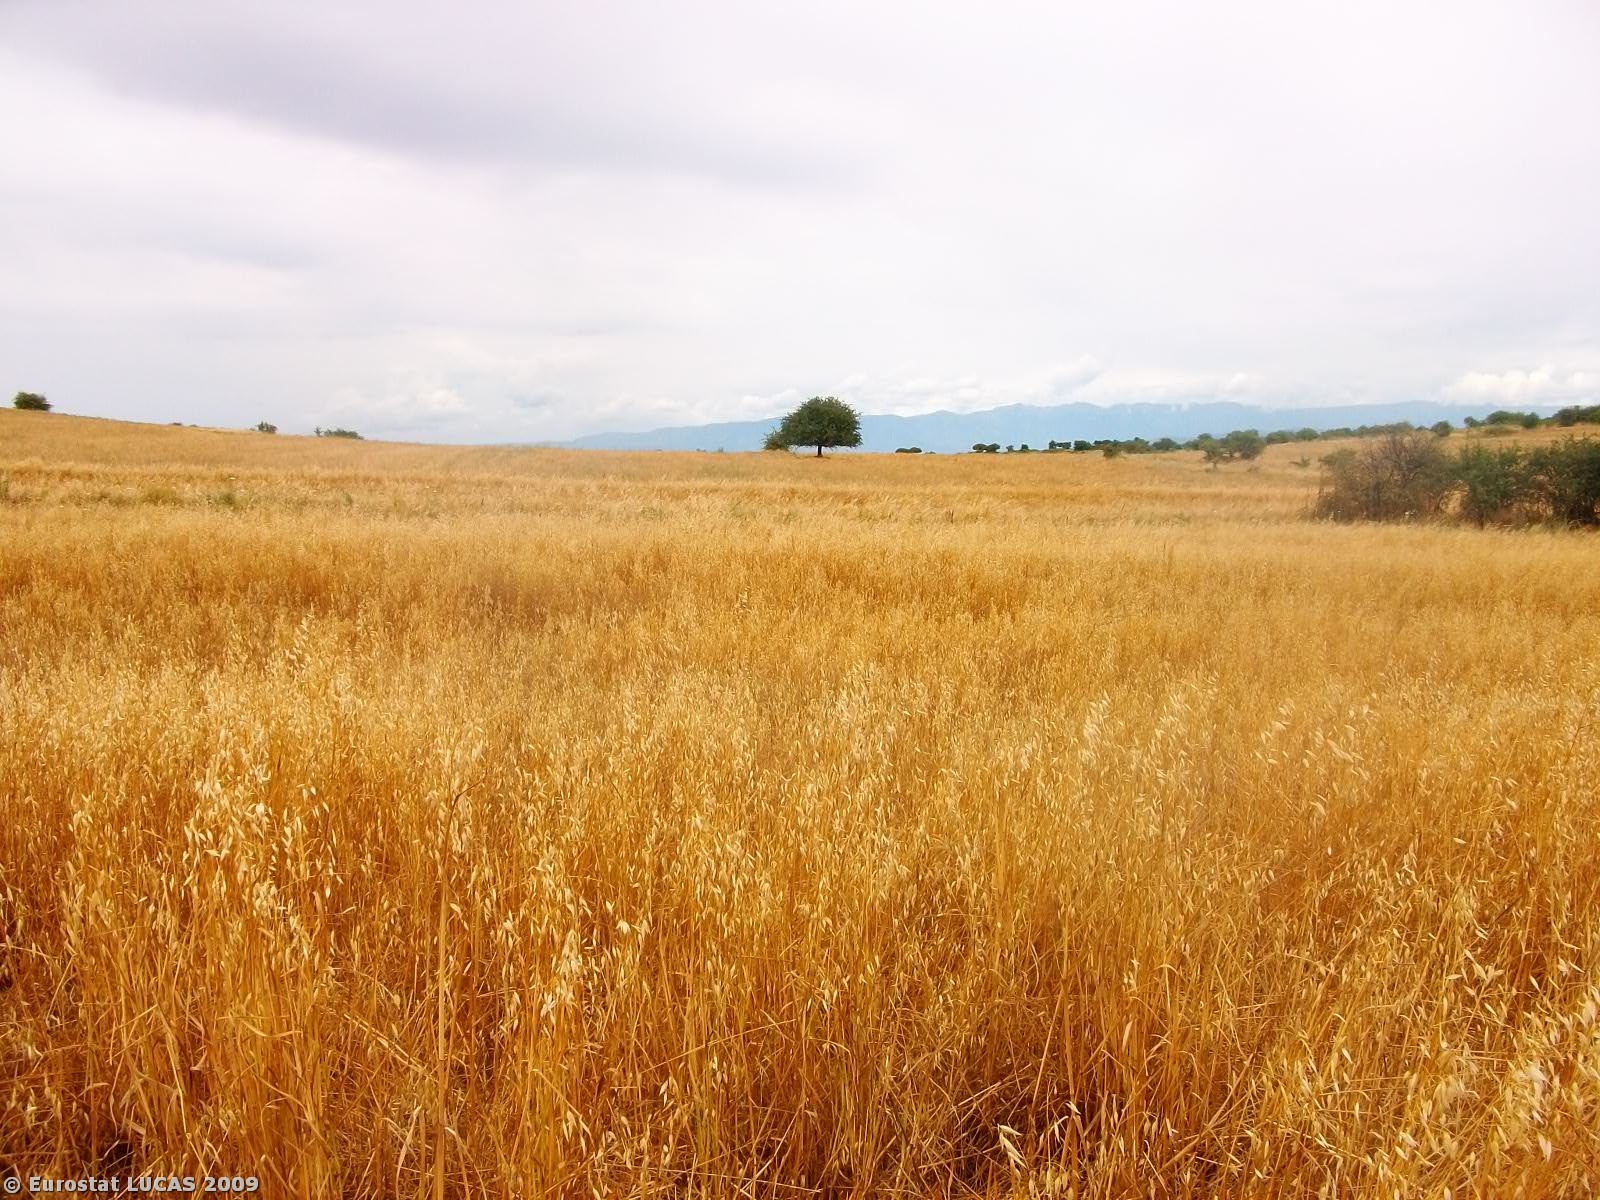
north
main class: Cropland
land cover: Durum wheat
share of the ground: > 75 %
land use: Agriculture (excluding fallow land and kitchen gardens)
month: June
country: GR
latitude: 40.9697
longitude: 22.7353
